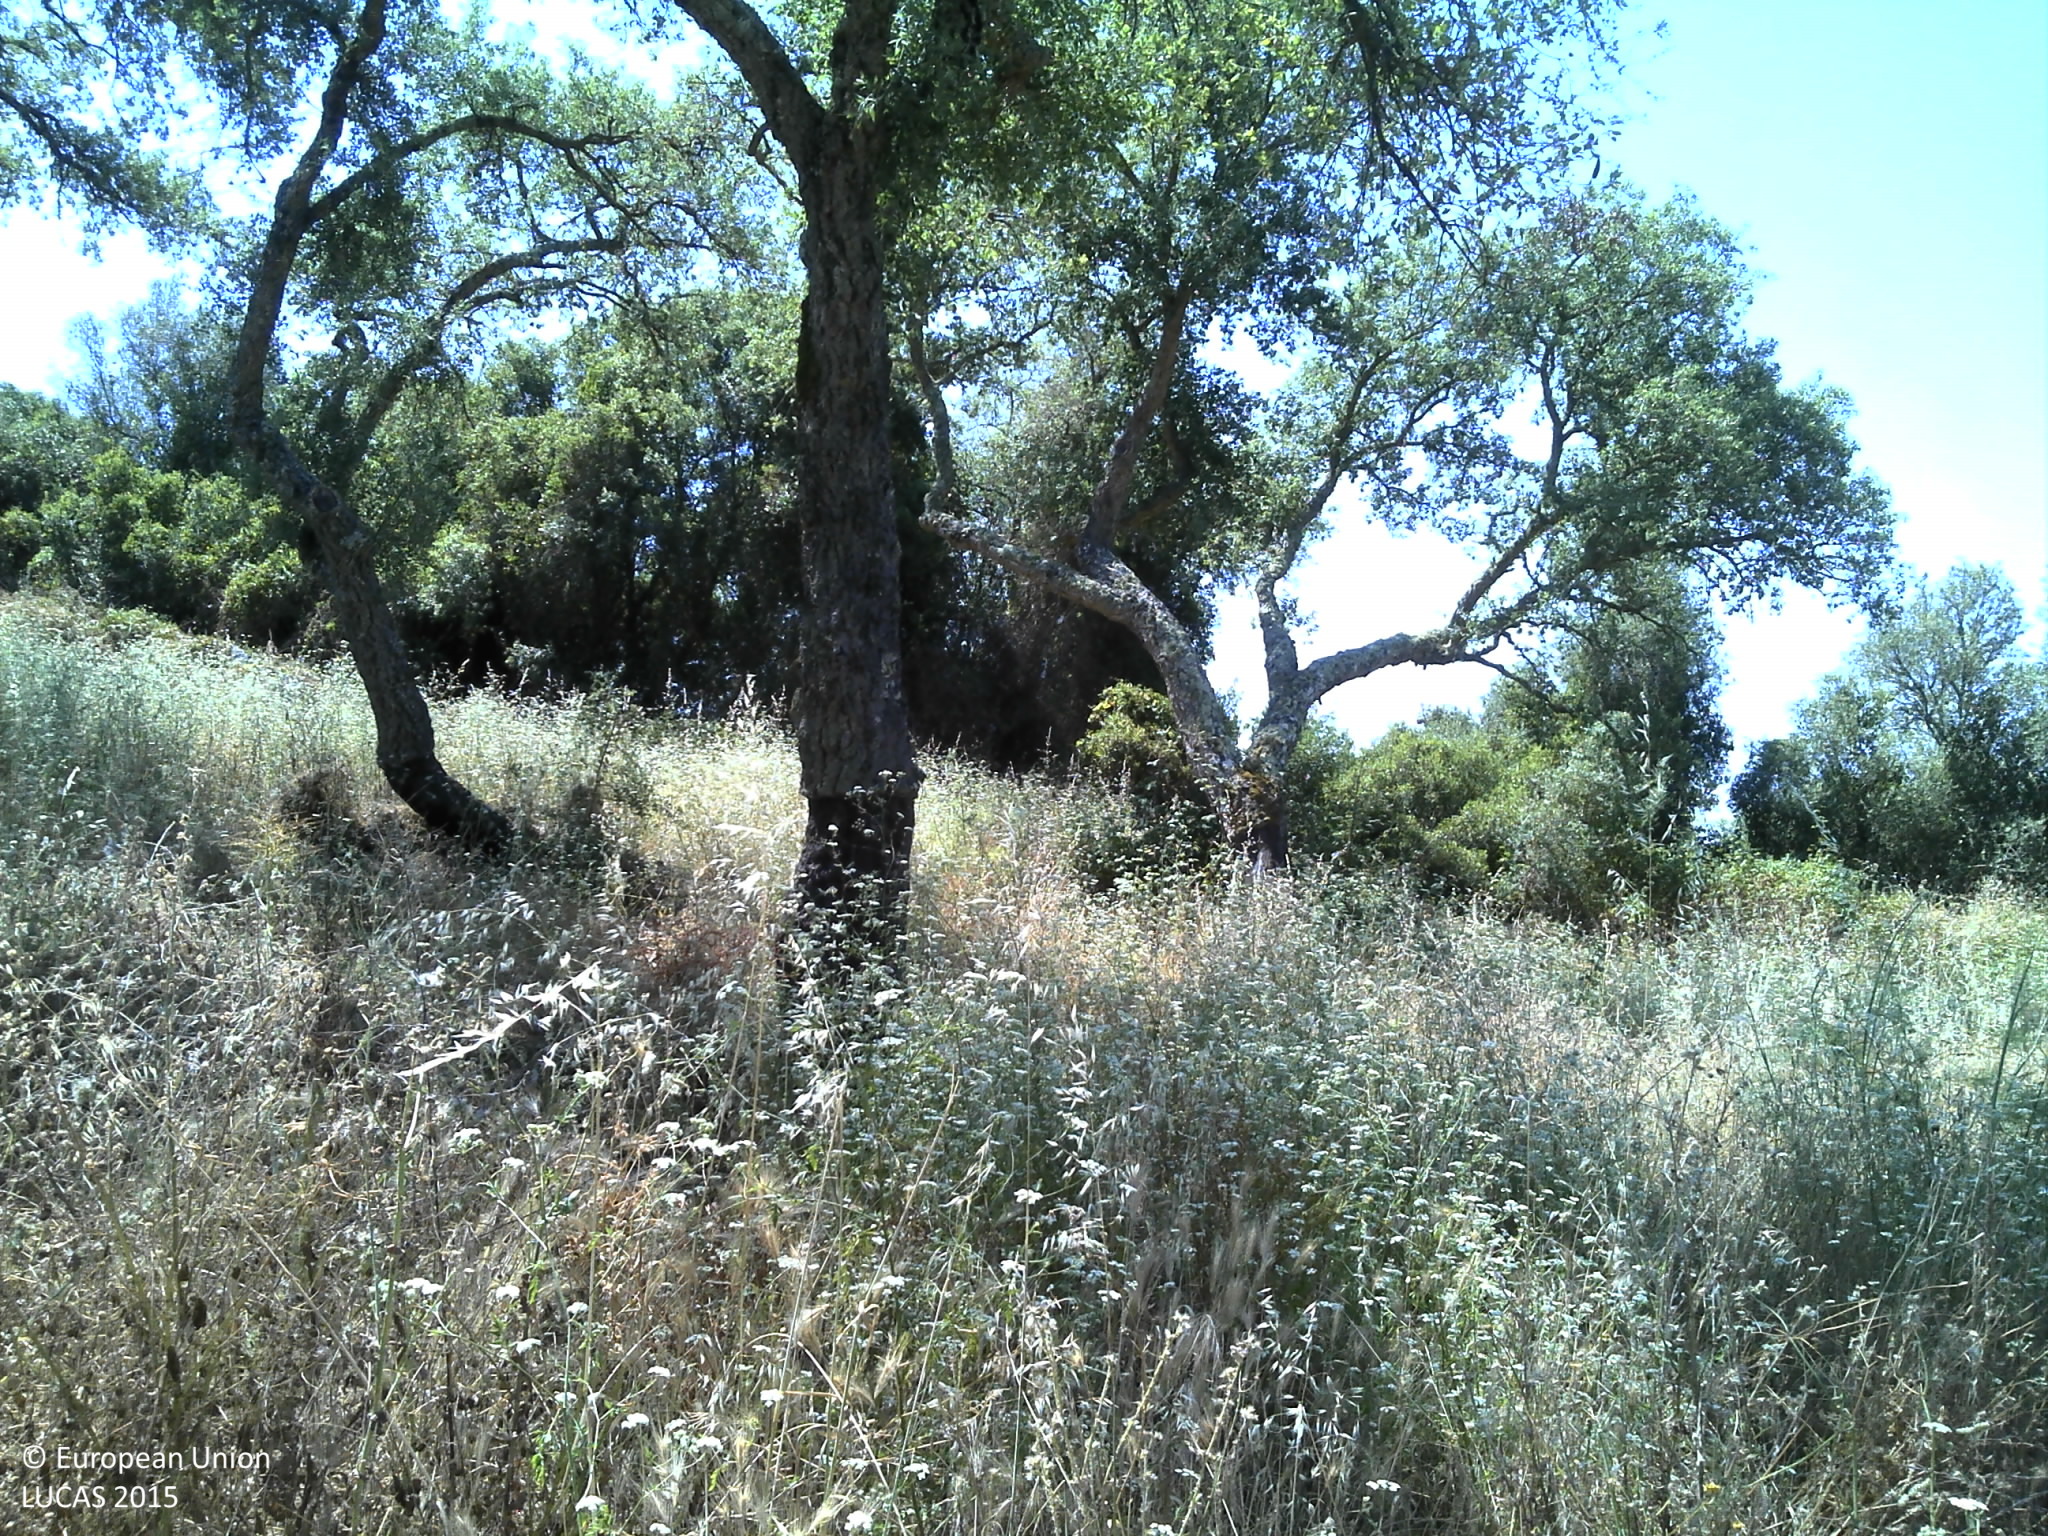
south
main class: Woodland
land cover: Broadleaved woodland
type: broadleaved evergreen forest
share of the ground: > 75 %
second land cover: Grassland without tree/shrub cover
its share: > 75 %
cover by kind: broadleaved forest trees 75 %, herbaceous plants 25 %
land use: Forestry
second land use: Agriculture (excluding fallow land and kitchen gardens)
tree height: > 5 m
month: June
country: PT
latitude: 38.6210
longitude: -8.1124
